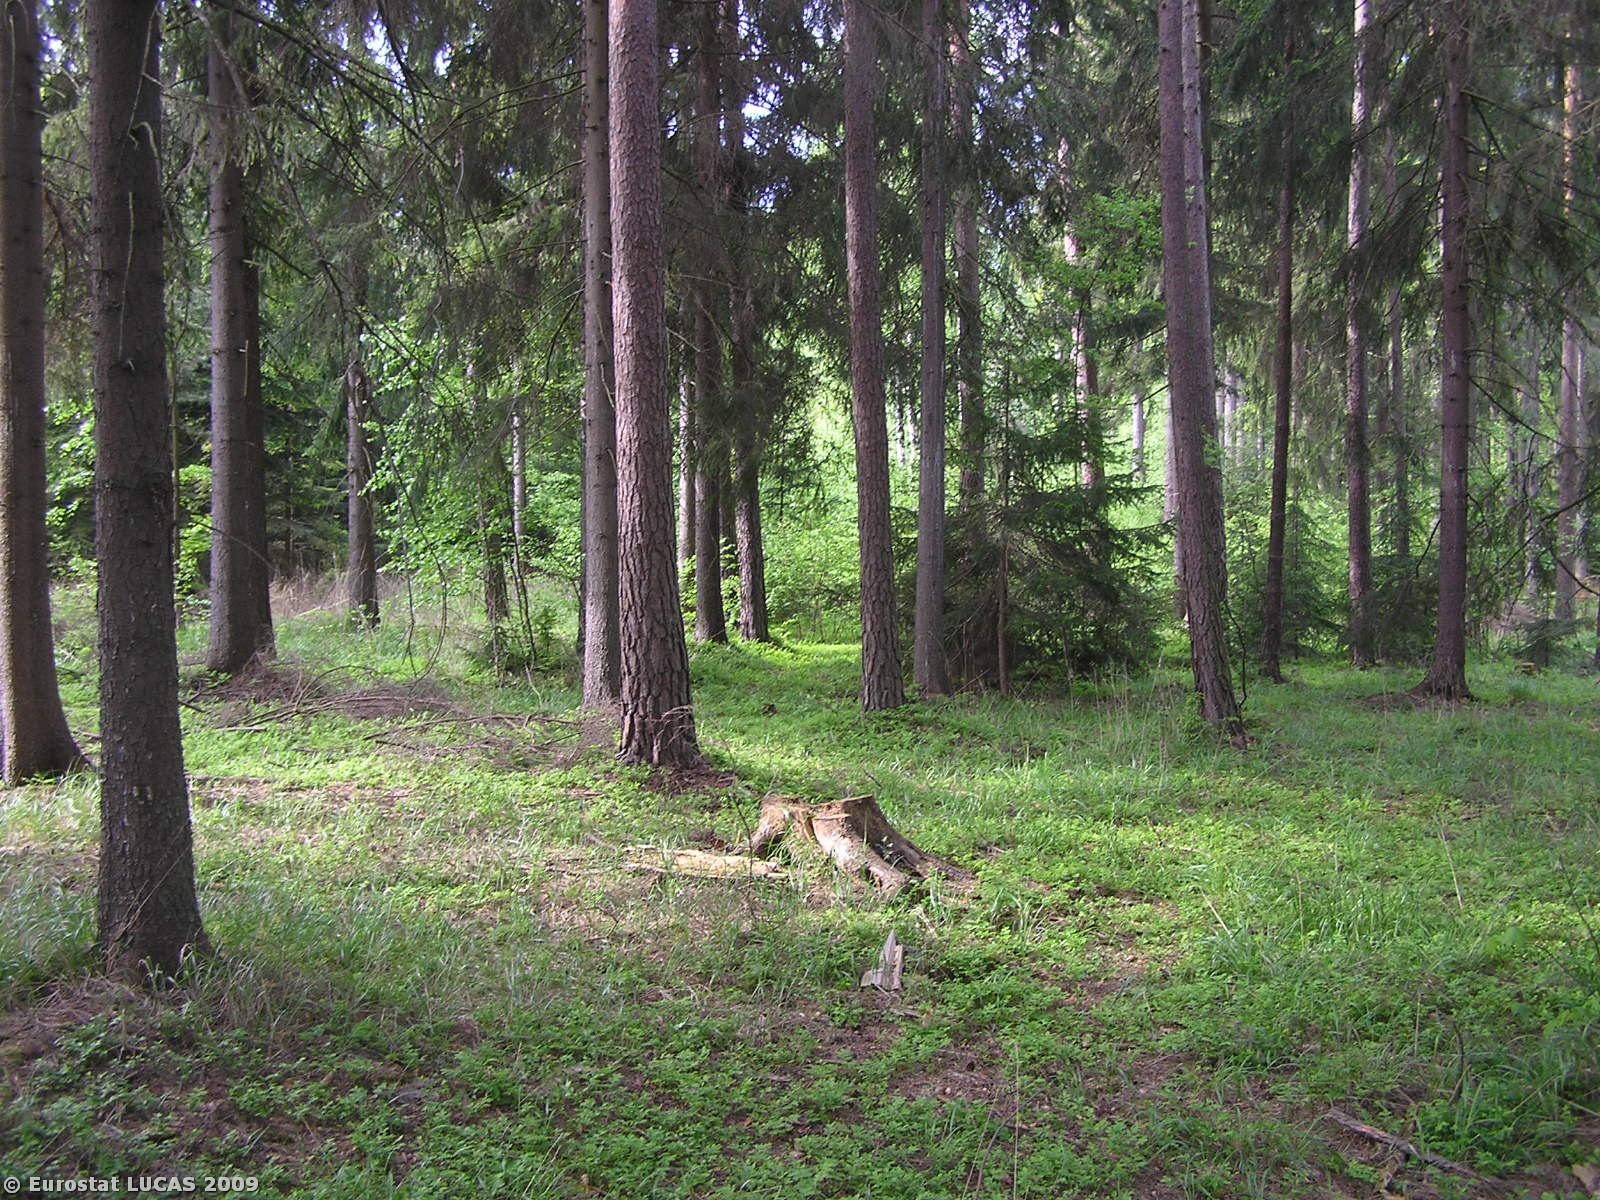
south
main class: Woodland
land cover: Coniferous woodland
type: hemiboreal forest and nemoral coniferous forest and mixed broadleaved-coniferous forest
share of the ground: > 75 %
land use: Forestry
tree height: > 5 m
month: May
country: CZ
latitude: 49.8943
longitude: 17.5996
